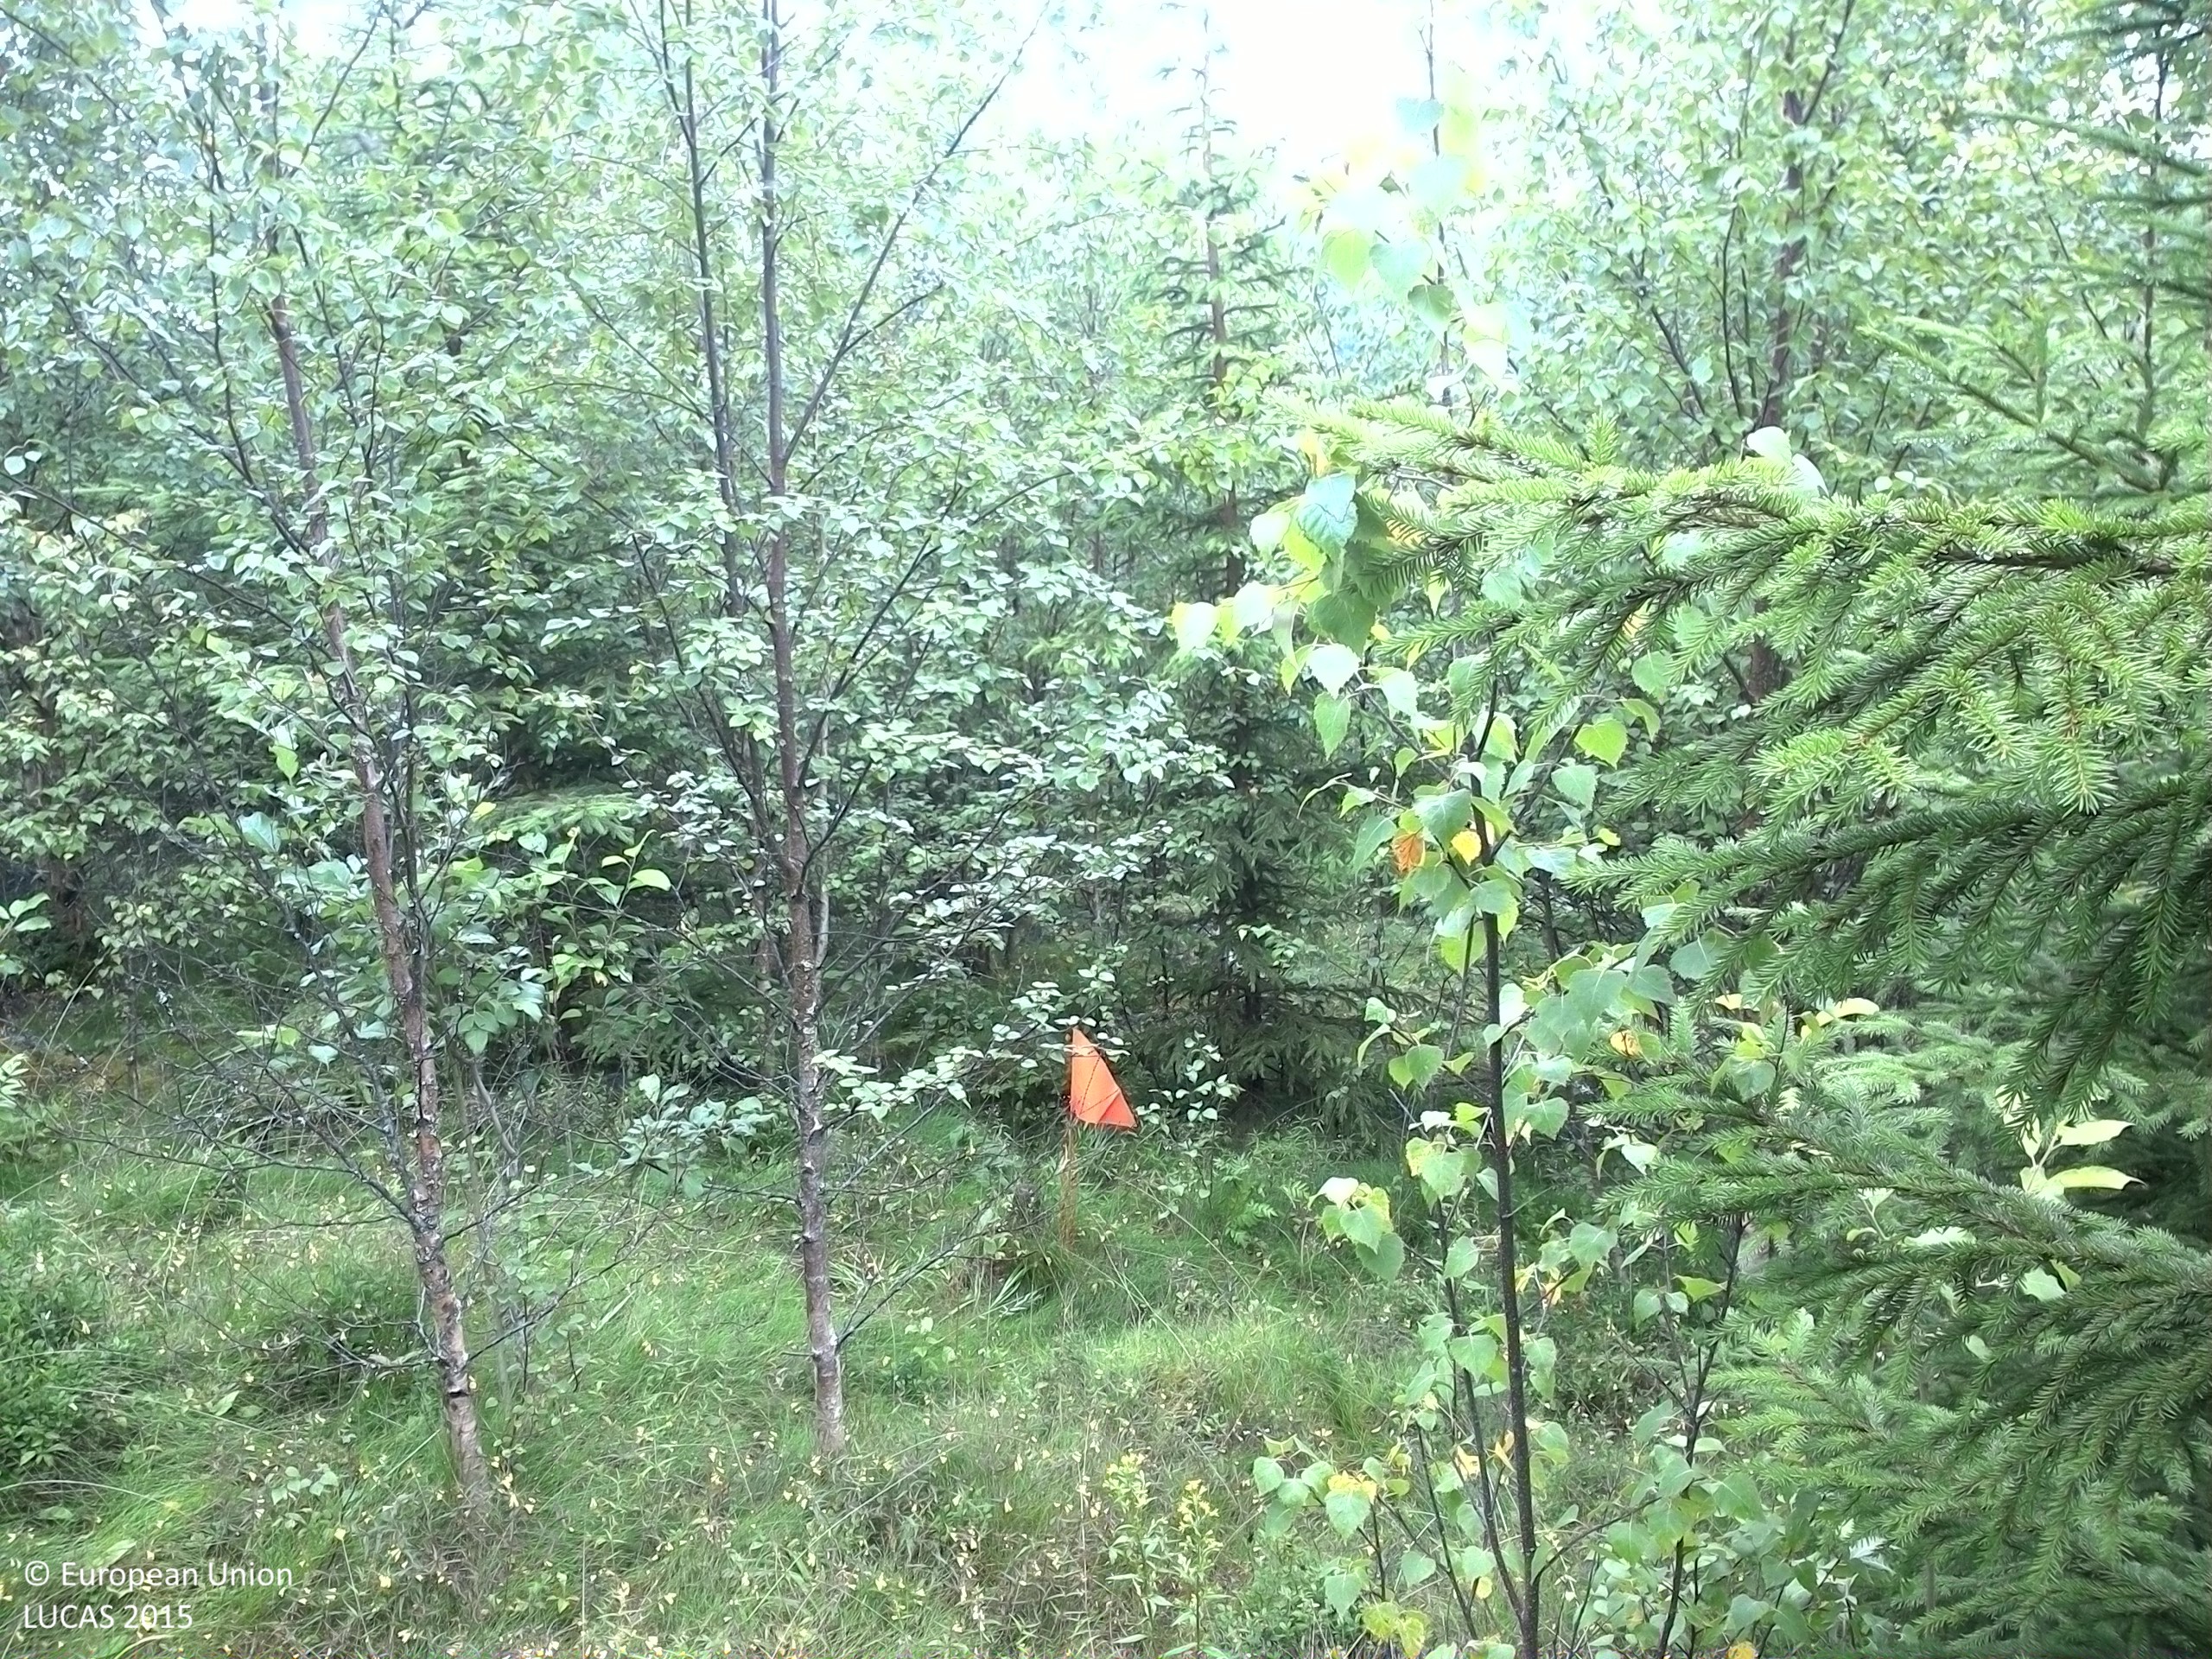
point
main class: Woodland
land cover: Spruce dominated mixed woodland
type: boreal forest
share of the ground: > 75 %
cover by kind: coniferous forest trees 45 %, broadleaved forest trees 35 %, herbaceous plants 15 %, shrubs 5 %
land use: Forestry
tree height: < 5 m
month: July
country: SE
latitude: 62.6566
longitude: 17.2188
